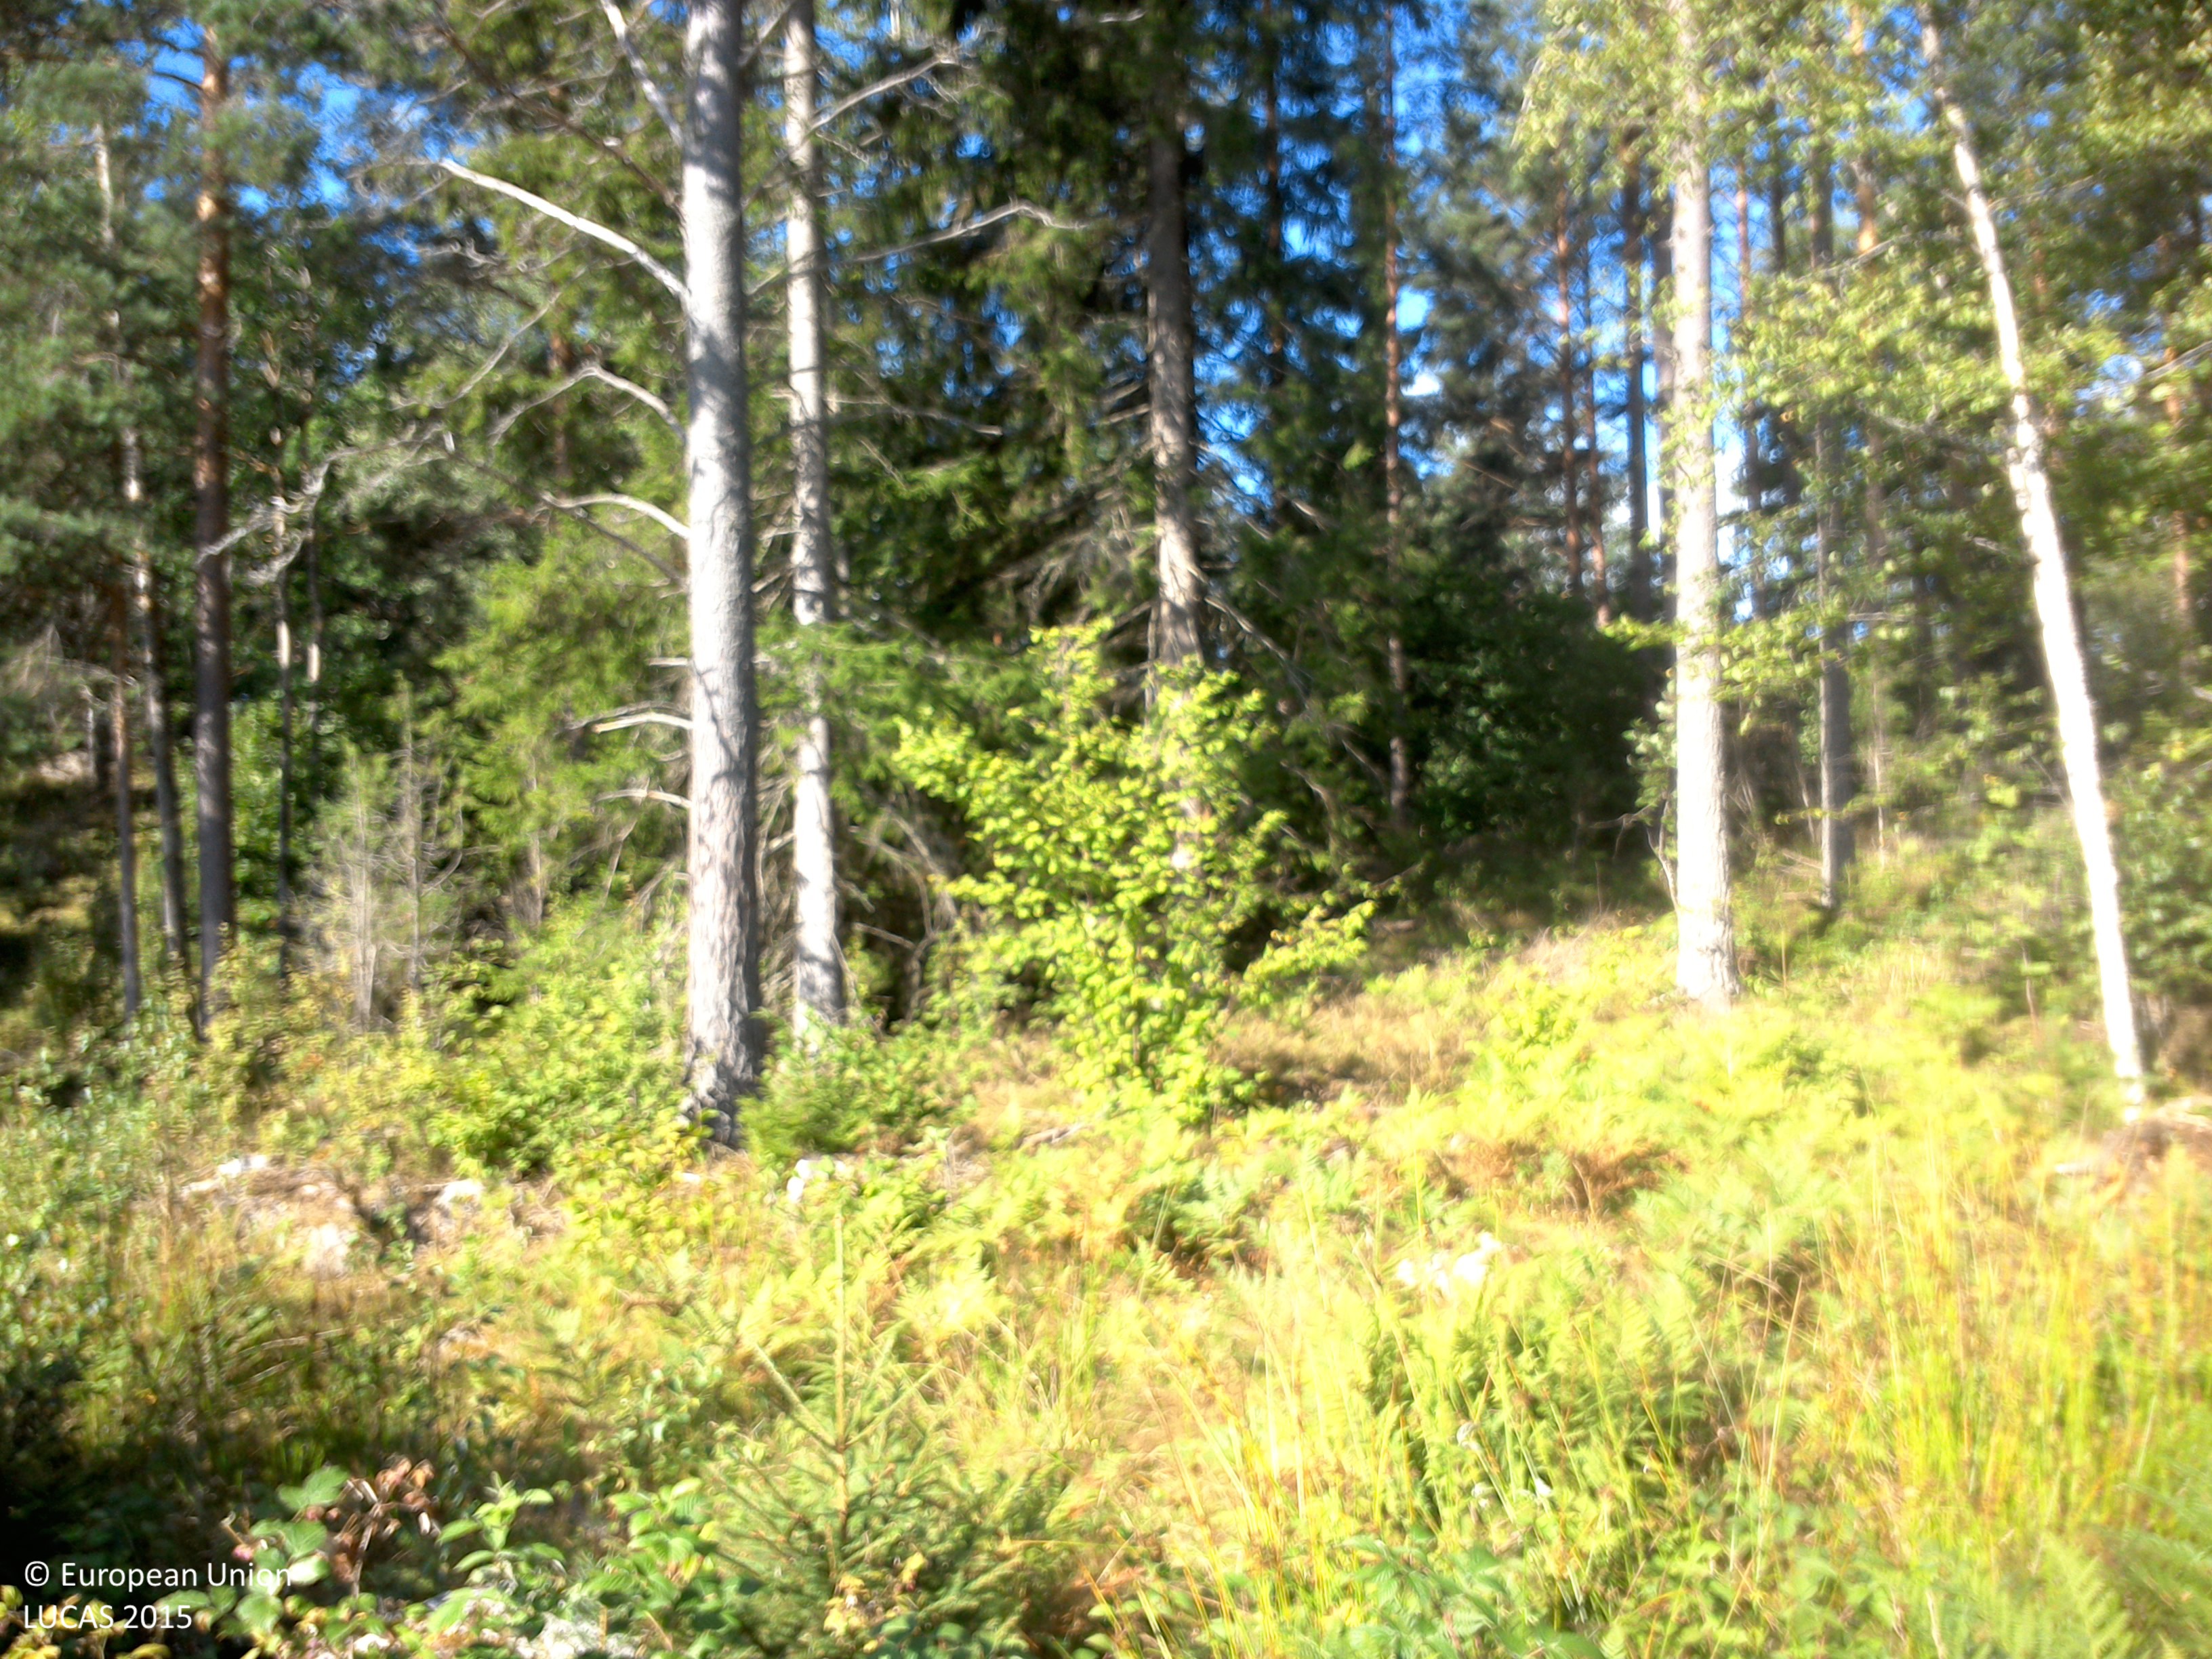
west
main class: Shrubland
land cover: Shrubland with sparse tree cover
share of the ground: 50 - 75 %
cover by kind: shrubs 55 %, herbaceous plants 40 %, broadleaved forest trees 5 %
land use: Forestry
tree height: < 5 m
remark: Clear cut
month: August
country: SE
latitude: 58.0390
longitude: 15.3984
